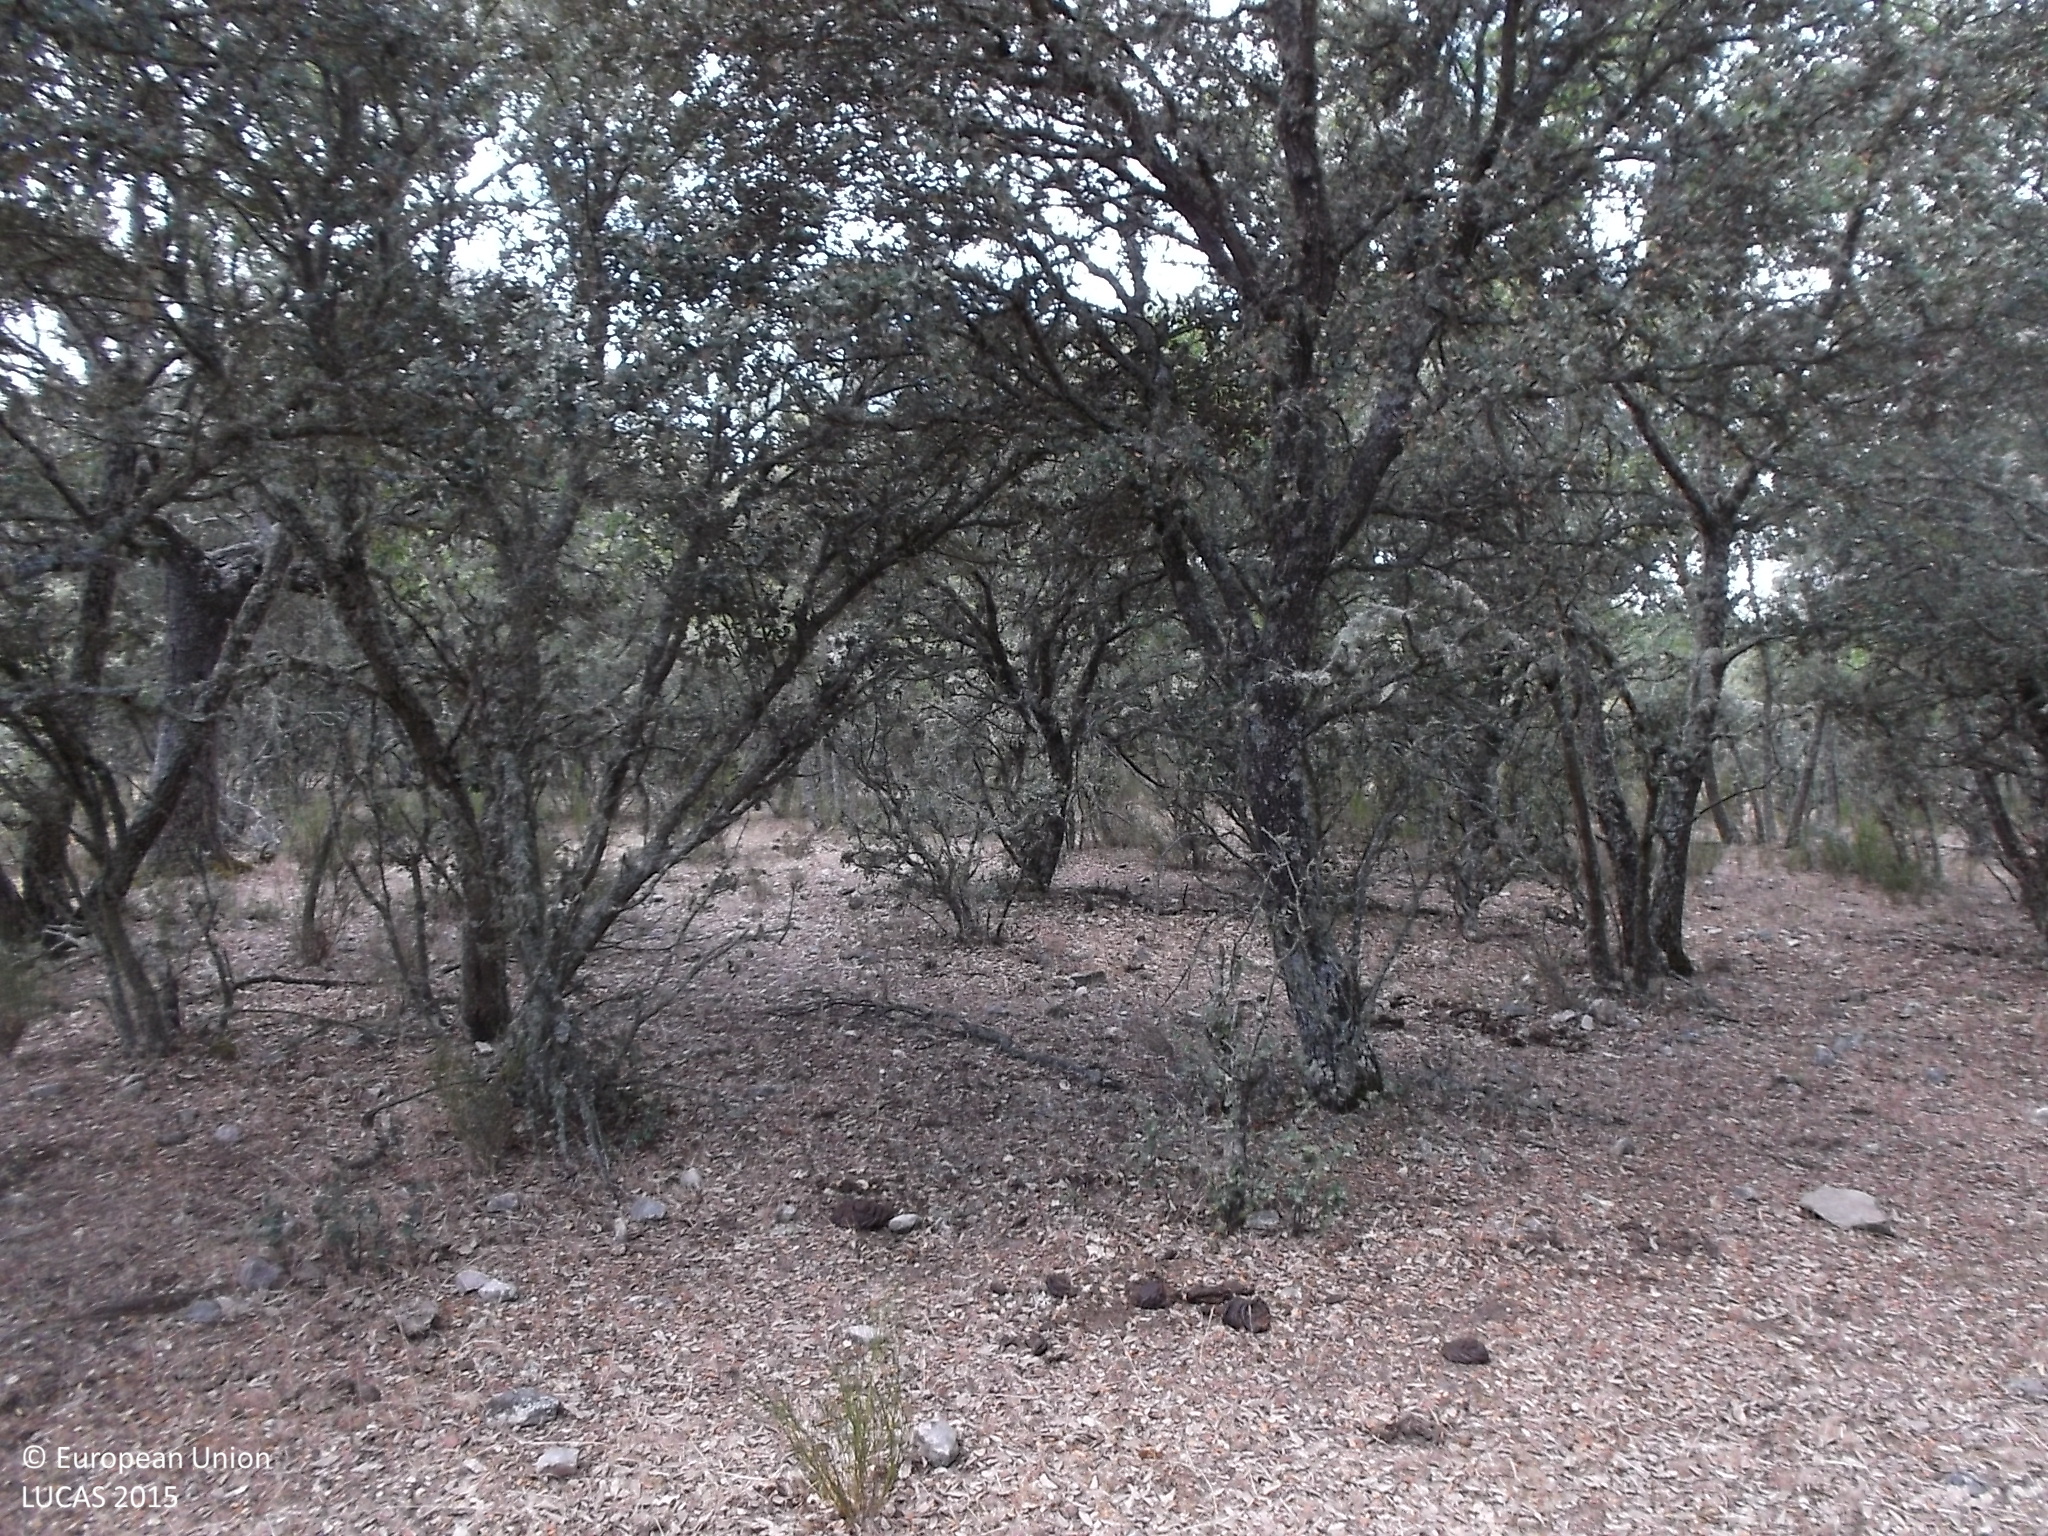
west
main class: Woodland
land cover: Broadleaved woodland
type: broadleaved evergreen forest
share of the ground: 25 - 50 %
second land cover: Shrubland without tree cover
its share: 25 - 50 %
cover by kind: broadleaved forest trees 40 %, shrubs 40 %, herbaceous plants 20 %
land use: Forestry
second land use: Agriculture (excluding fallow land and kitchen gardens)
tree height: < 5 m
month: July
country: ES
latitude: 40.9034
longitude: -6.3905
